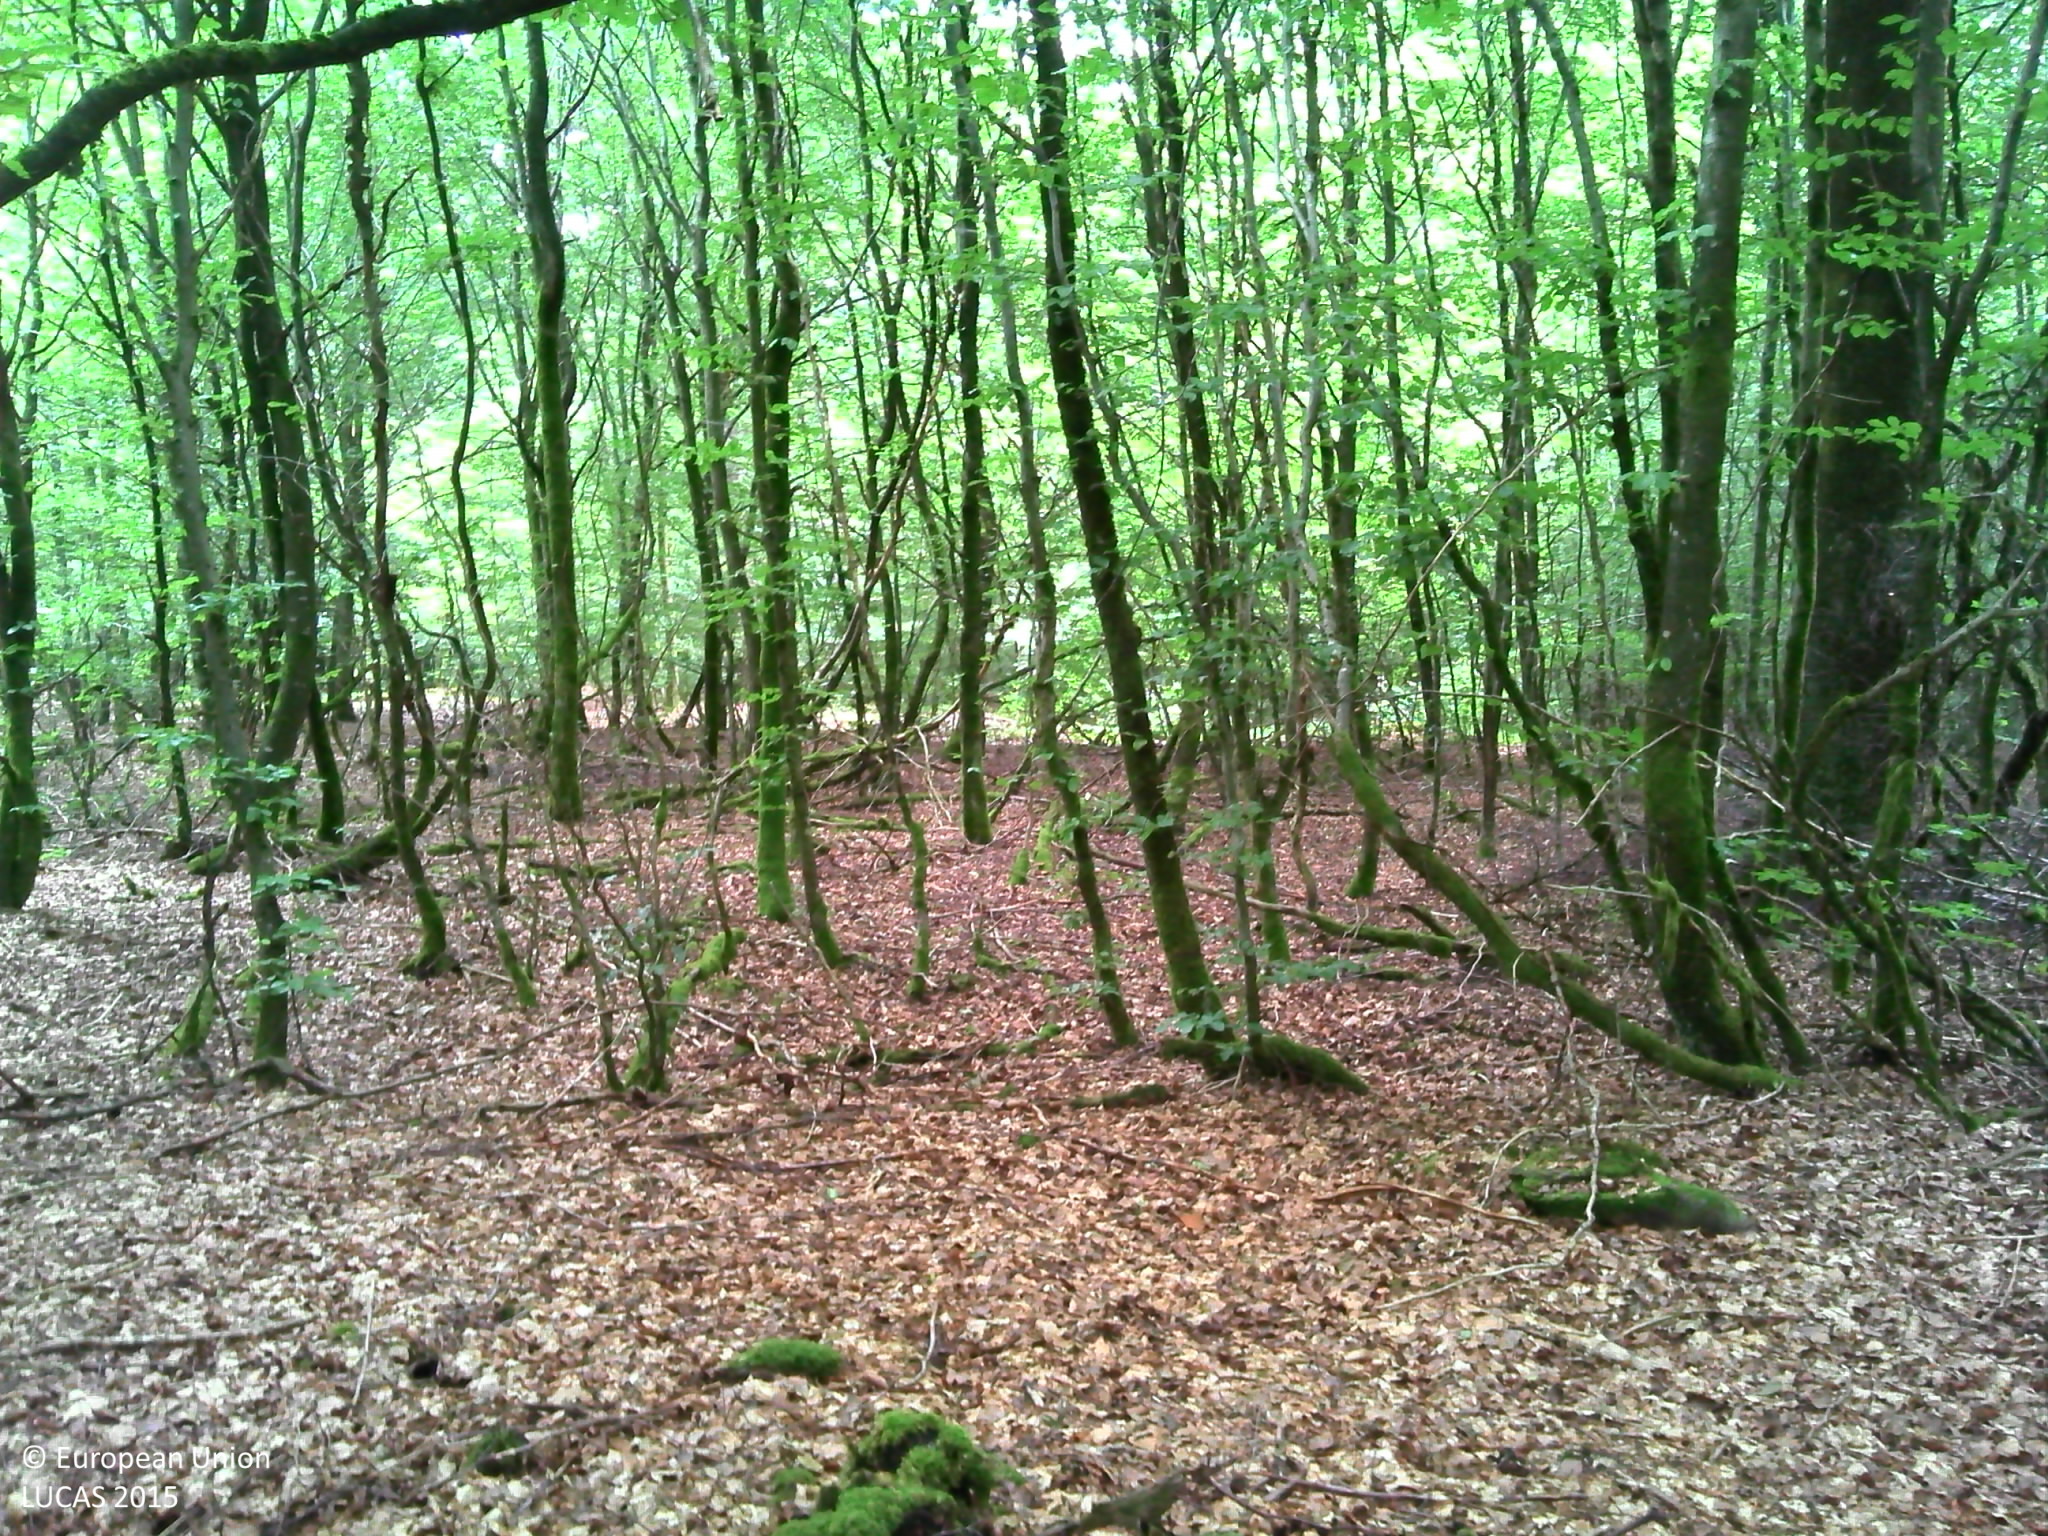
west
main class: Woodland
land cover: Broadleaved woodland
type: beech forest
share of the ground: > 75 %
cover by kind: broadleaved forest trees 100 %
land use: Forestry
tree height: > 5 m
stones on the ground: < 10 %
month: July
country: BE
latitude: 49.7593
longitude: 5.6537
